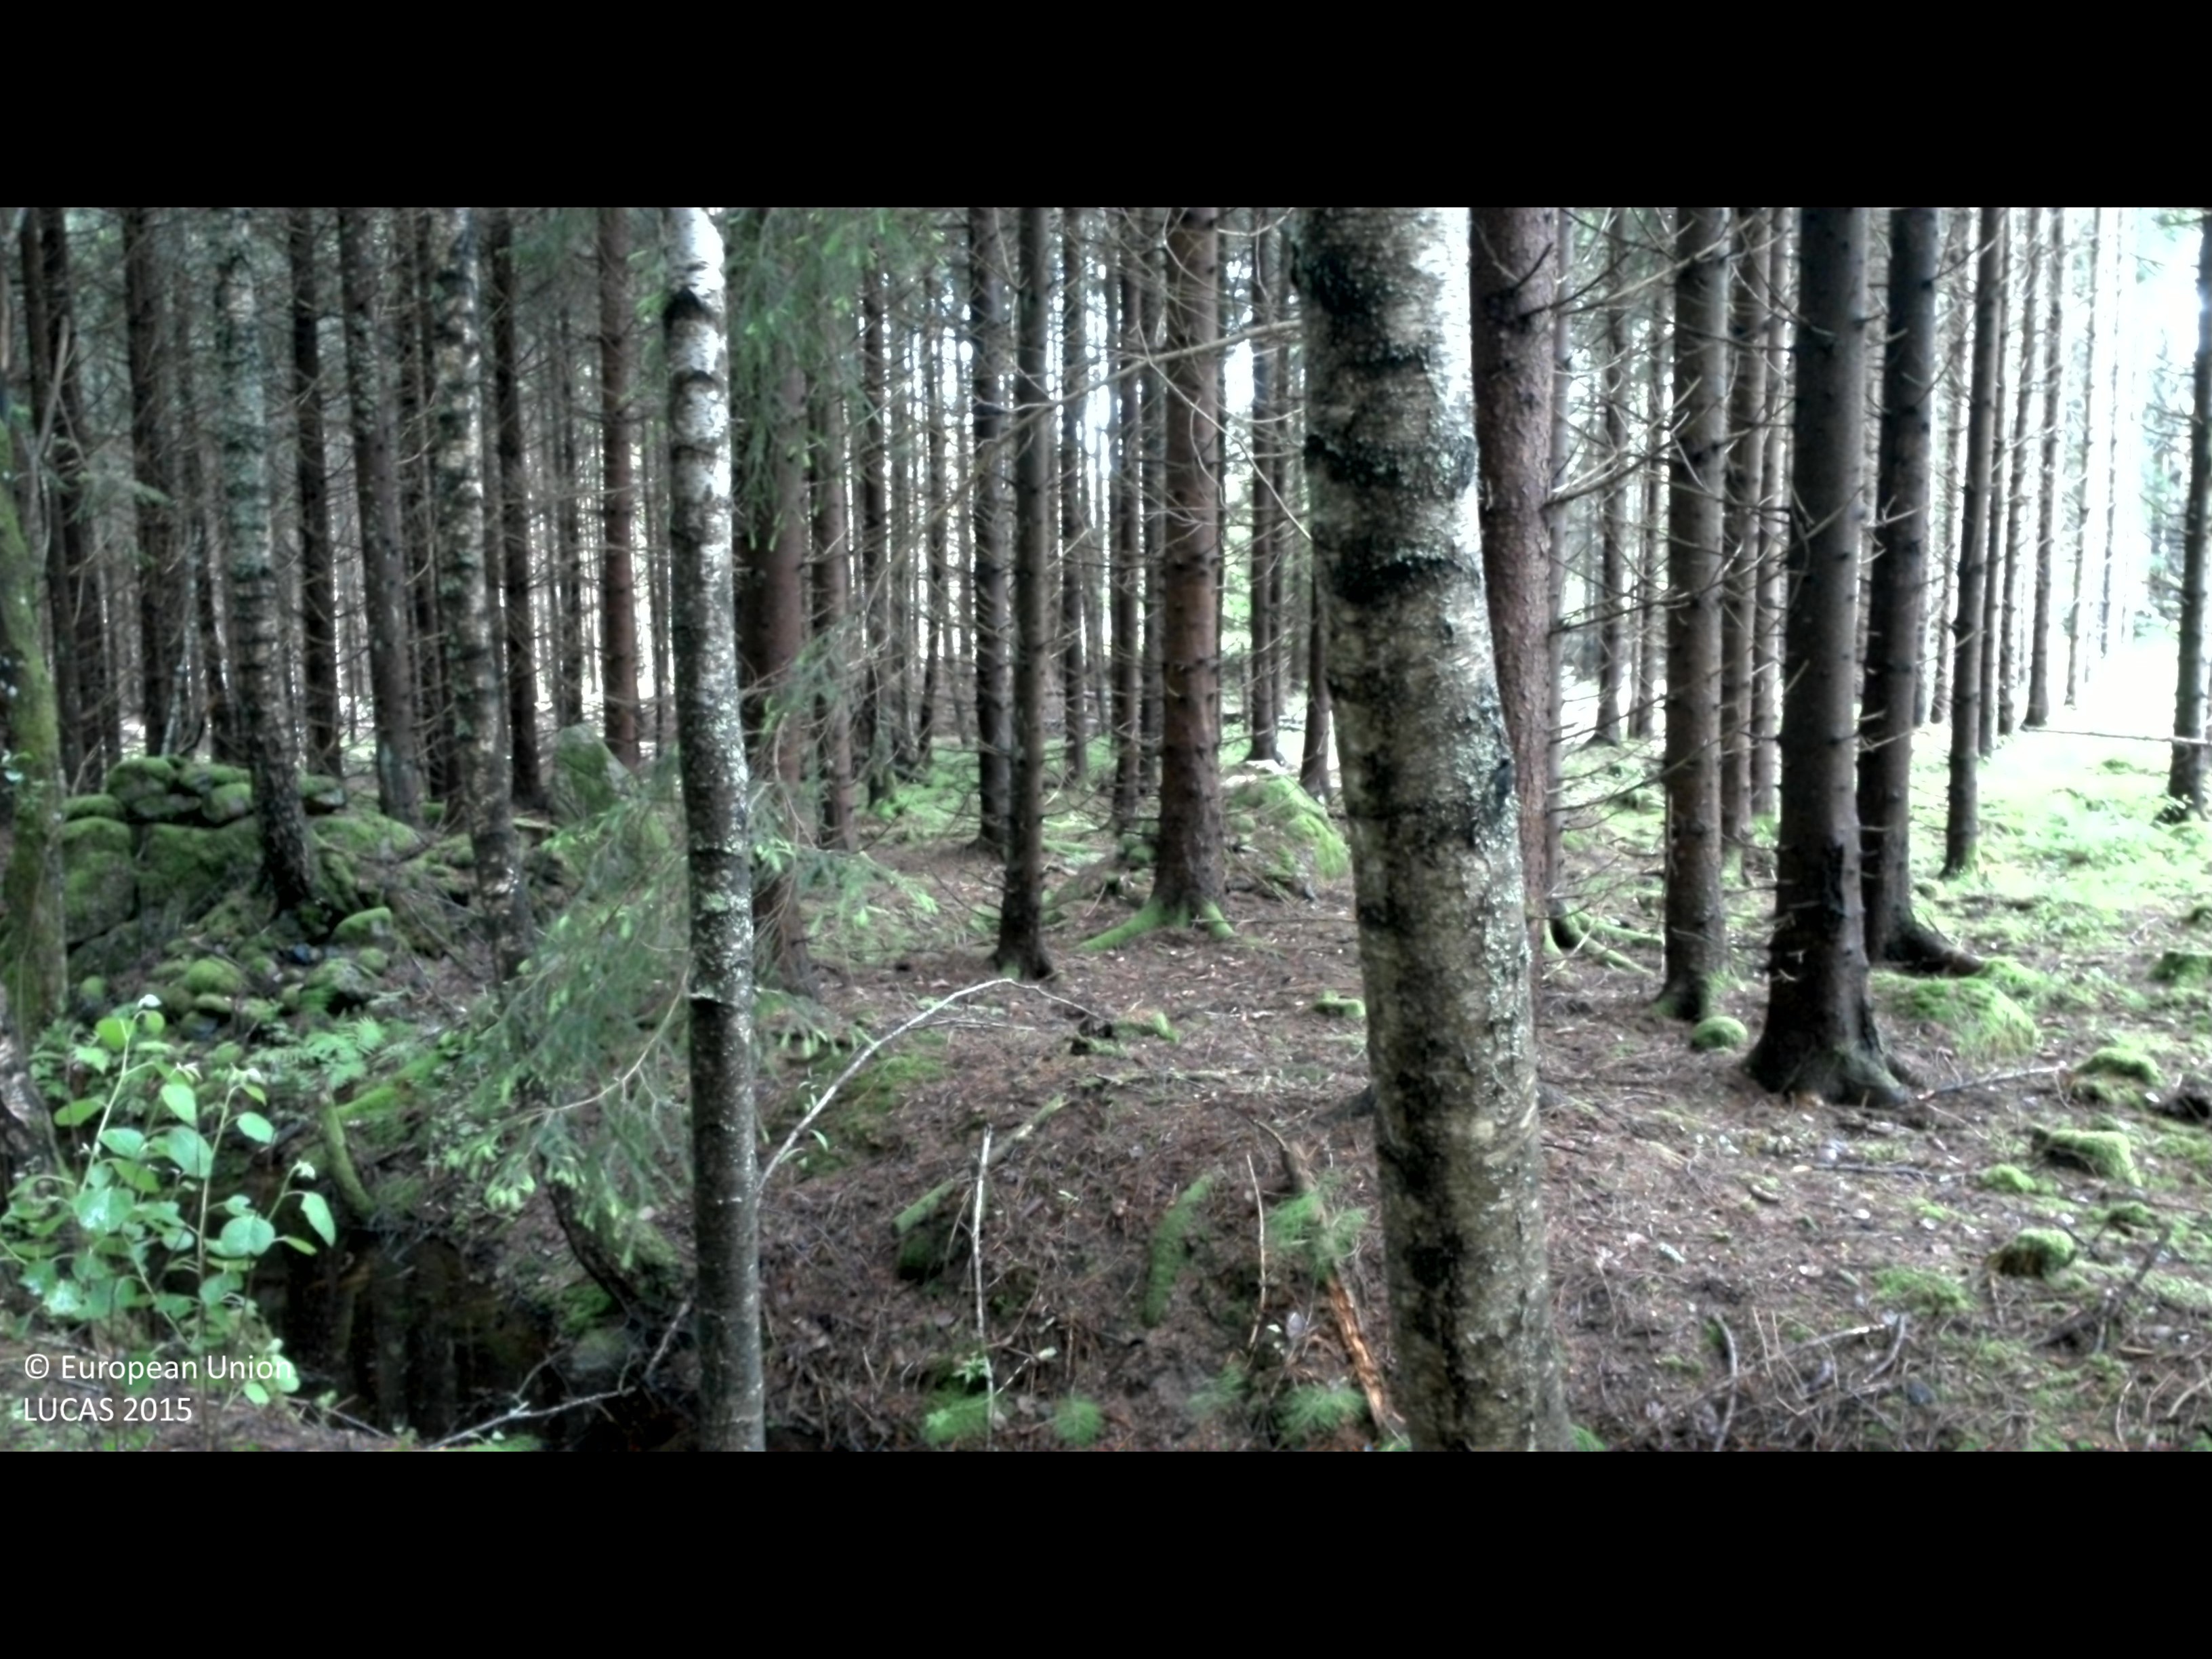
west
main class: Woodland
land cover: Spruce dominated coniferous woodland
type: boreal forest
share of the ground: > 75 %
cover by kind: coniferous forest trees 85 %, lichens and mosses 10 %, broadleaved forest trees 5 %
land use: Forestry
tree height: > 5 m
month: June
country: SE
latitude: 58.1161
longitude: 16.1241
